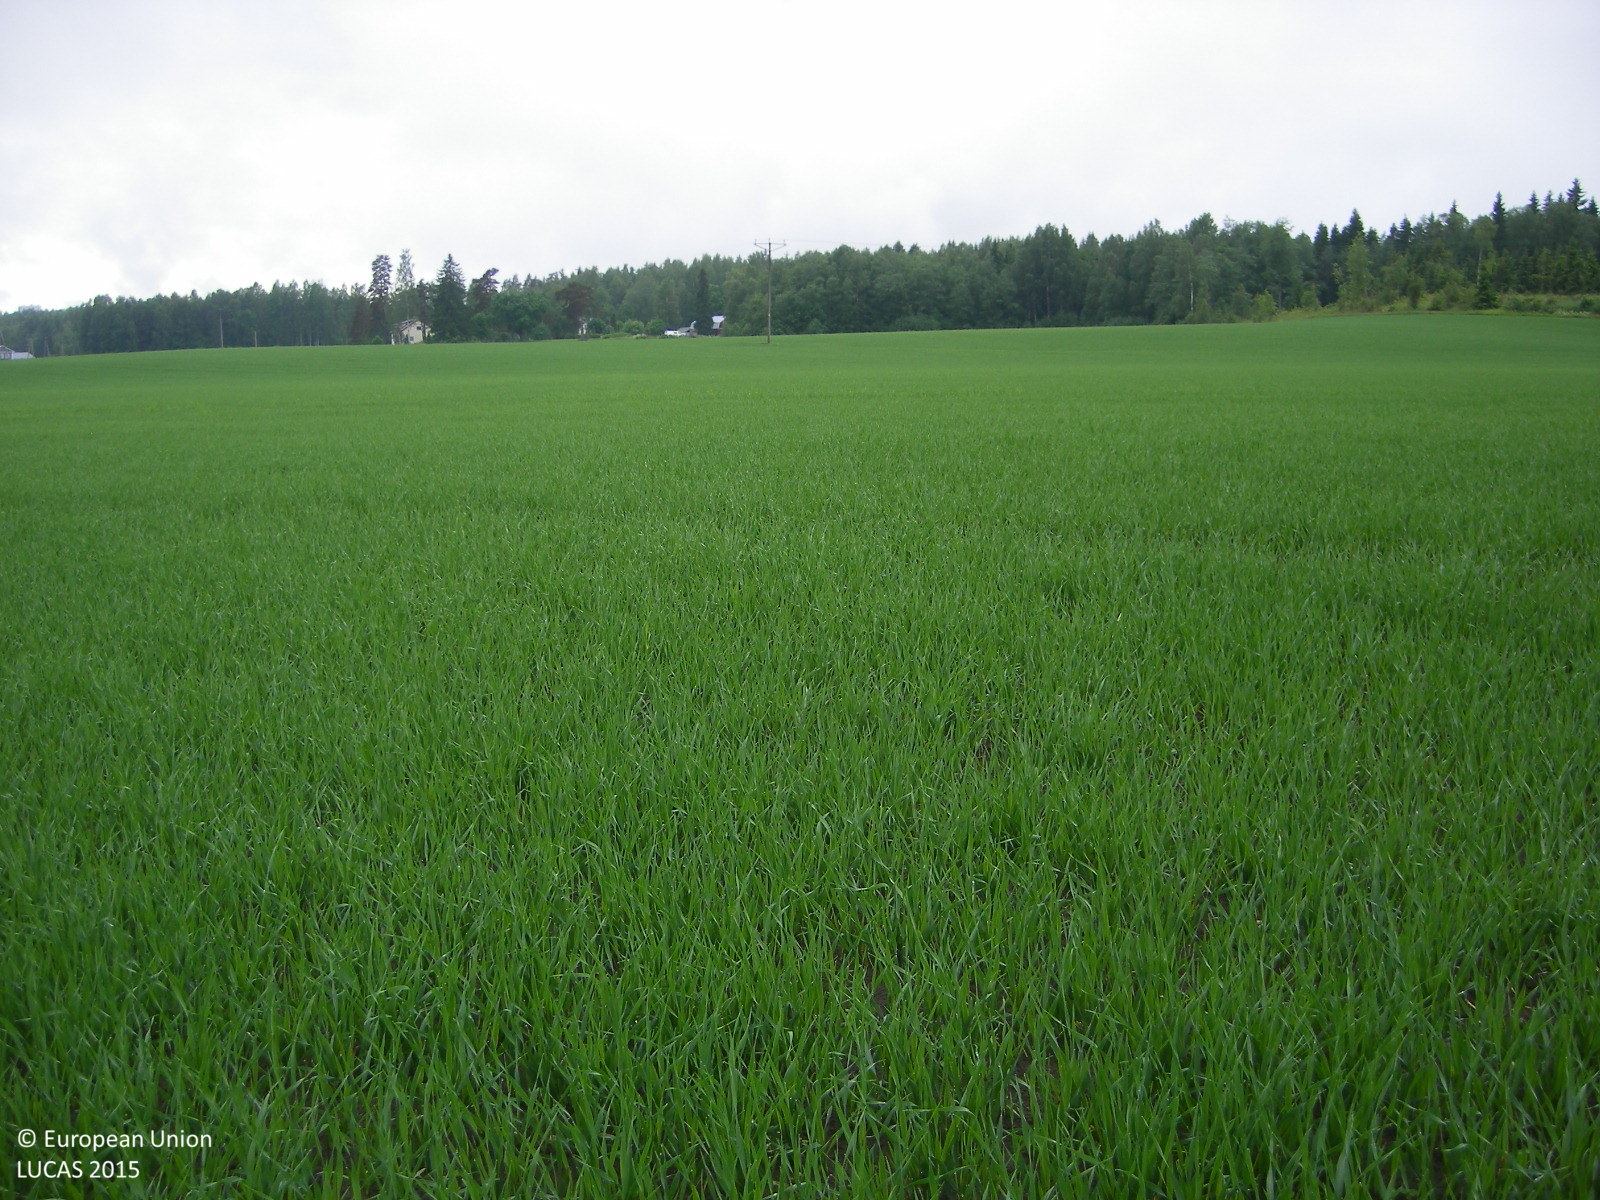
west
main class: Cropland
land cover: Common wheat
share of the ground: > 75 %
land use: Agriculture (excluding fallow land and kitchen gardens)
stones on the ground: < 10 %
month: June
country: FI
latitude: 60.1463
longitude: 23.9103
